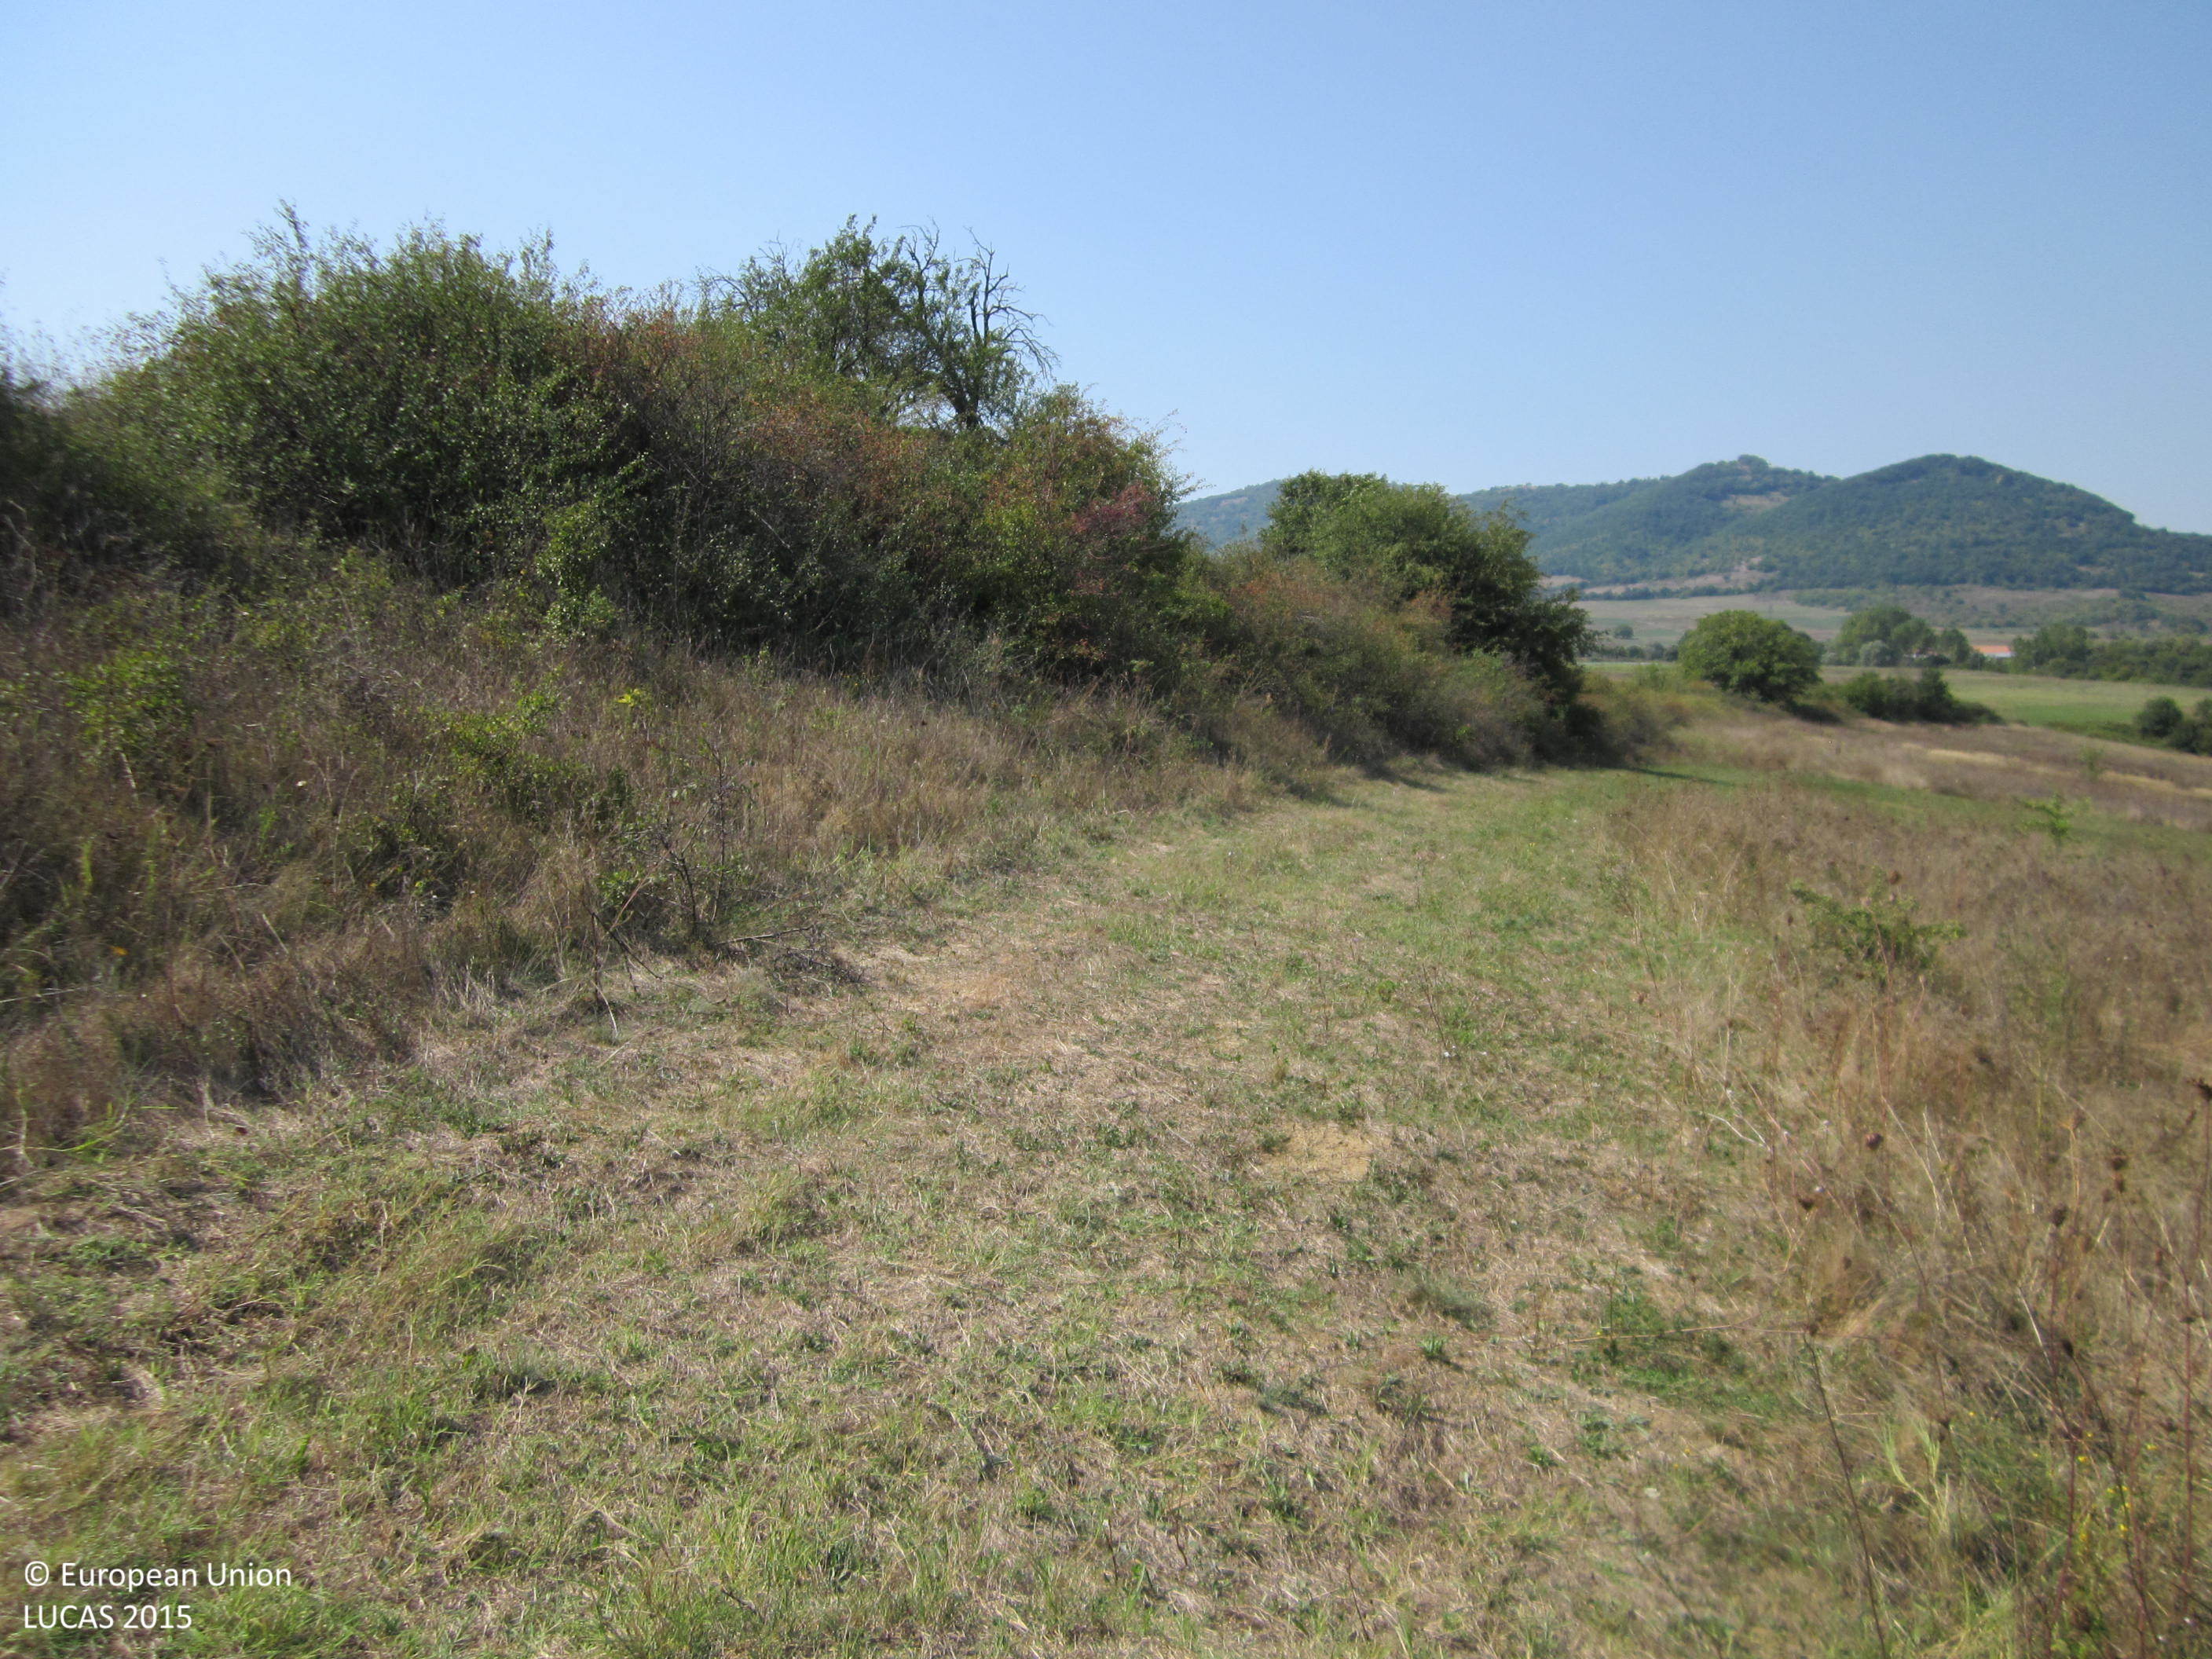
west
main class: Grassland
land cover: Grassland with sparse tree/shrub cover
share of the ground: > 75 %
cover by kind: herbaceous plants 90 %, broadleaved forest trees 5 %, shrubs 5 %
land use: Agriculture (excluding fallow land and kitchen gardens)
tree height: < 5 m
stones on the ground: < 10 %
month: September
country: BG
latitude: 42.9362
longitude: 27.2103
